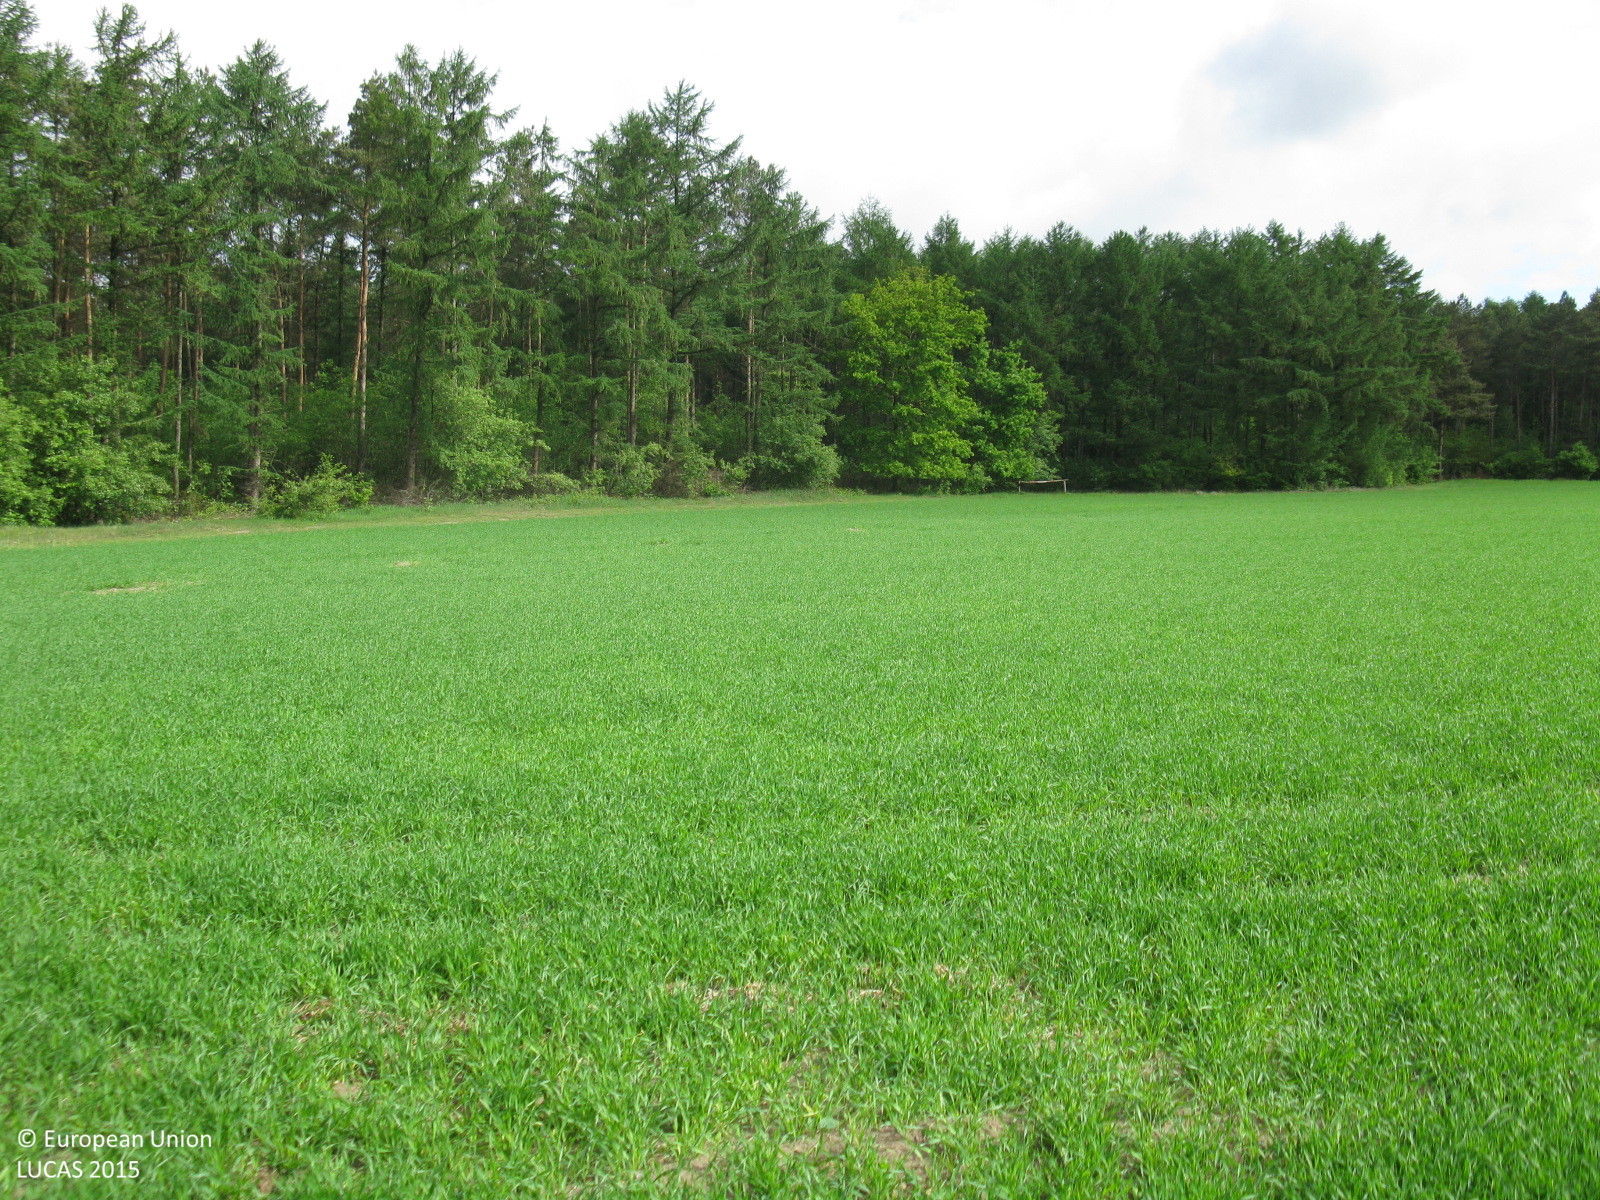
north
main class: Cropland
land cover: Barley
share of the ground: > 75 %
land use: Agriculture (excluding fallow land and kitchen gardens)
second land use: Community services
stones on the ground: < 10 %
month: May
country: DE
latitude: 52.8173
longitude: 7.4335
